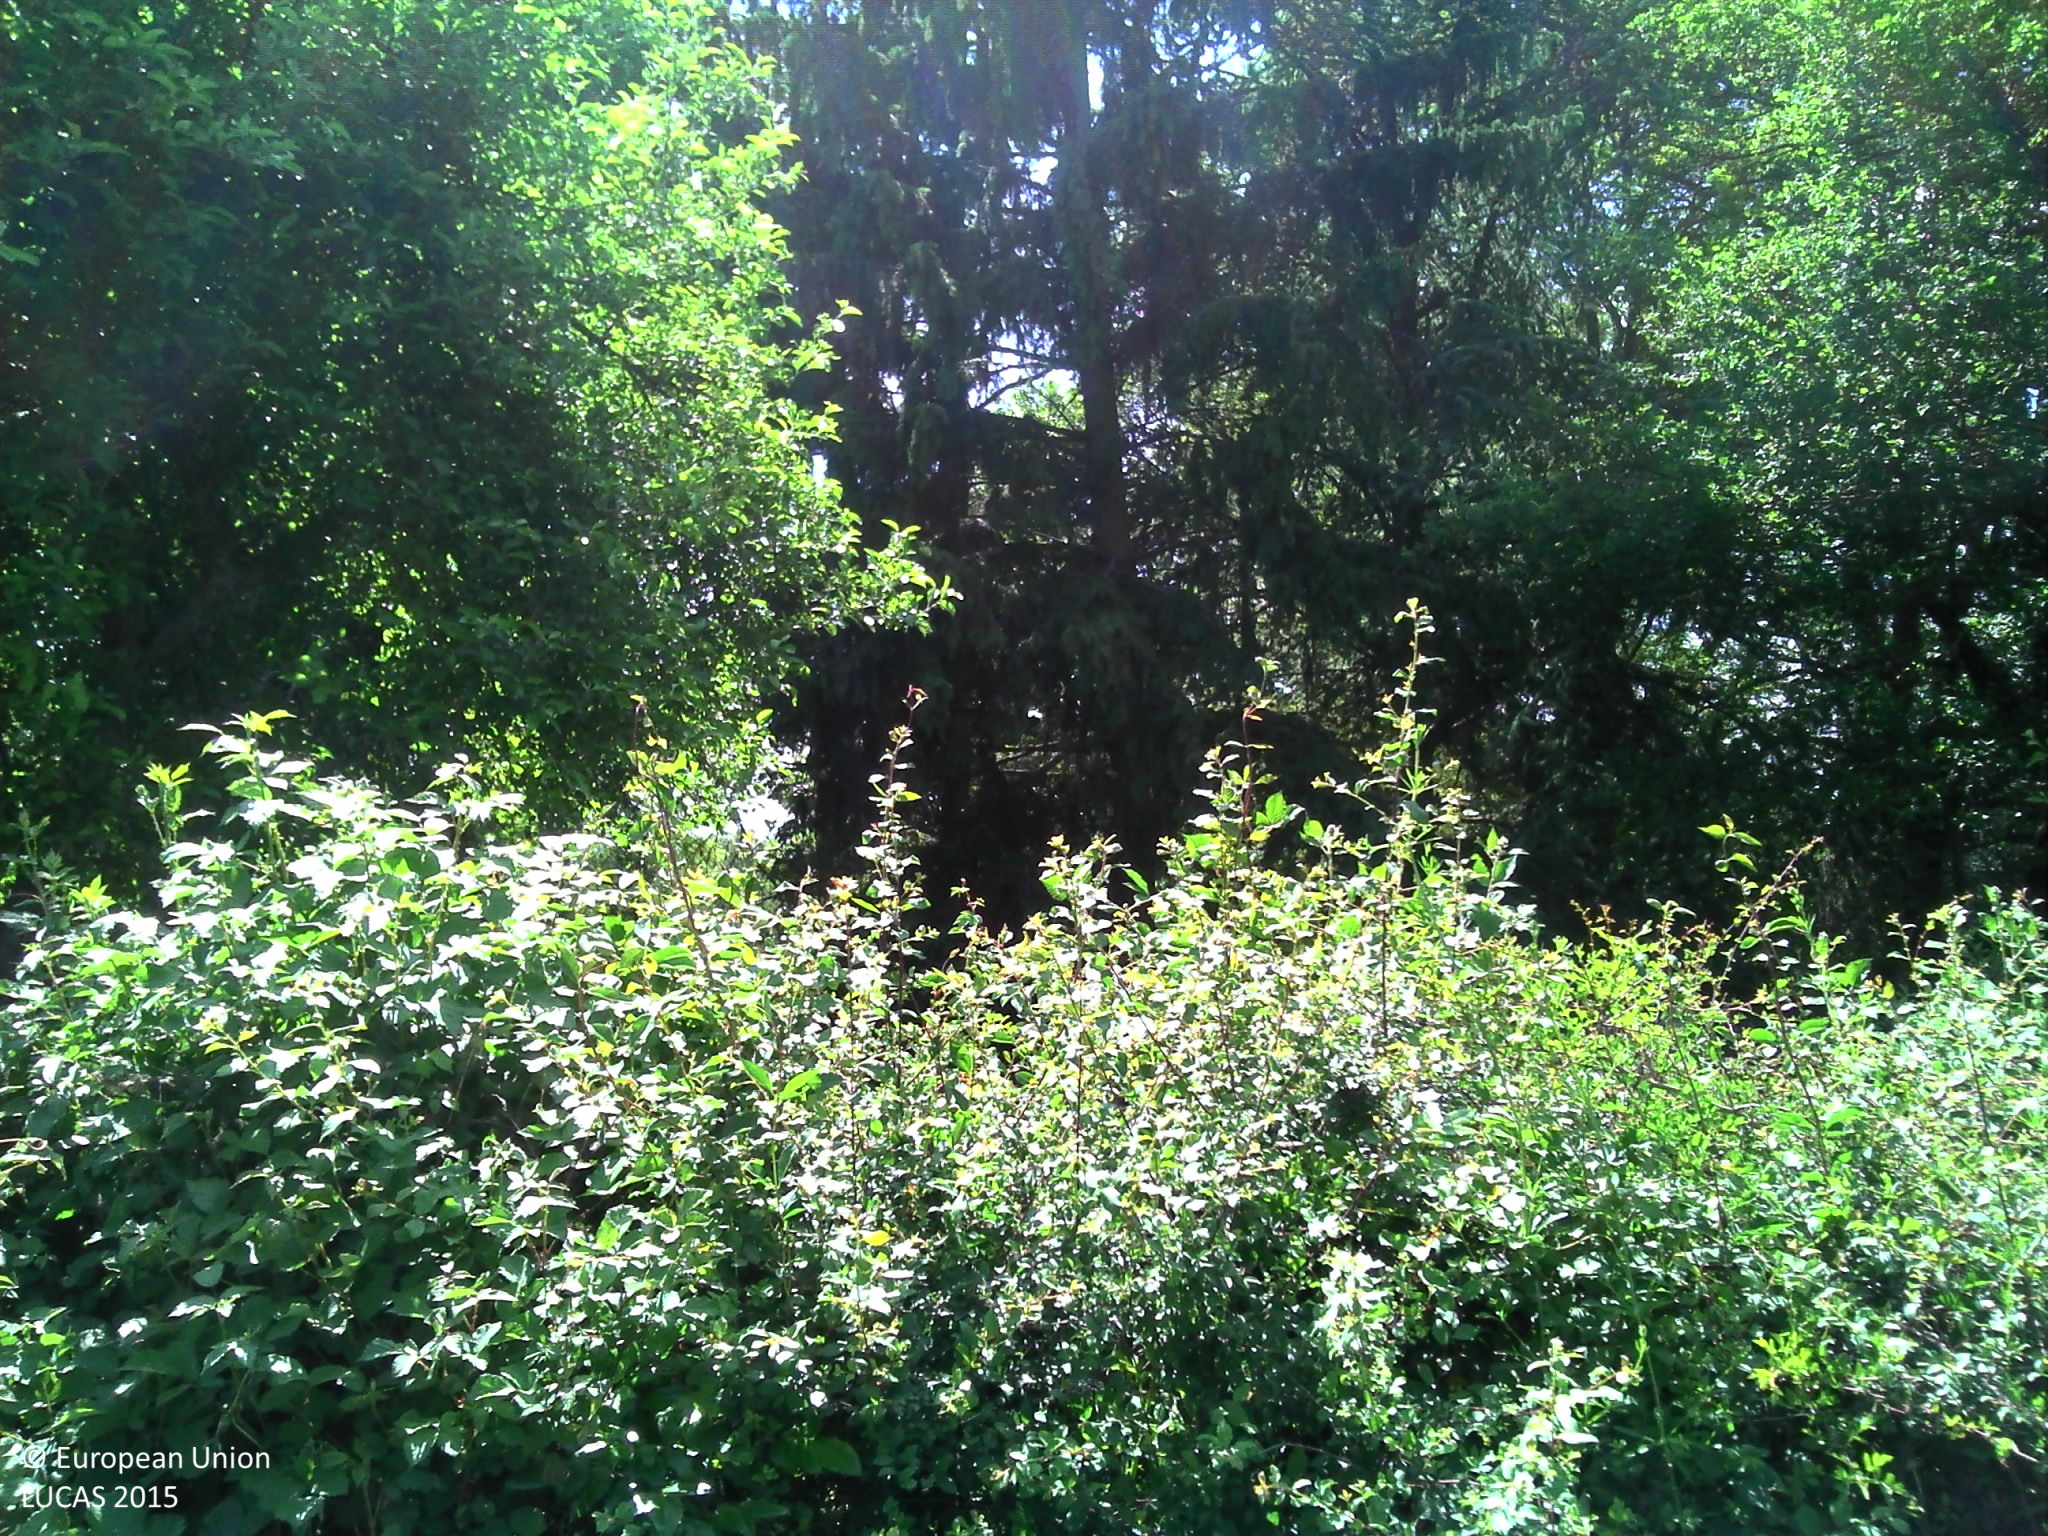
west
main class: Woodland
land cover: Spruce dominated mixed woodland
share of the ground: > 75 %
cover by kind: broadleaved forest trees 75 %, coniferous forest trees 25 %
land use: Residential
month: May
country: FR
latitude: 46.3211
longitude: 2.7365
